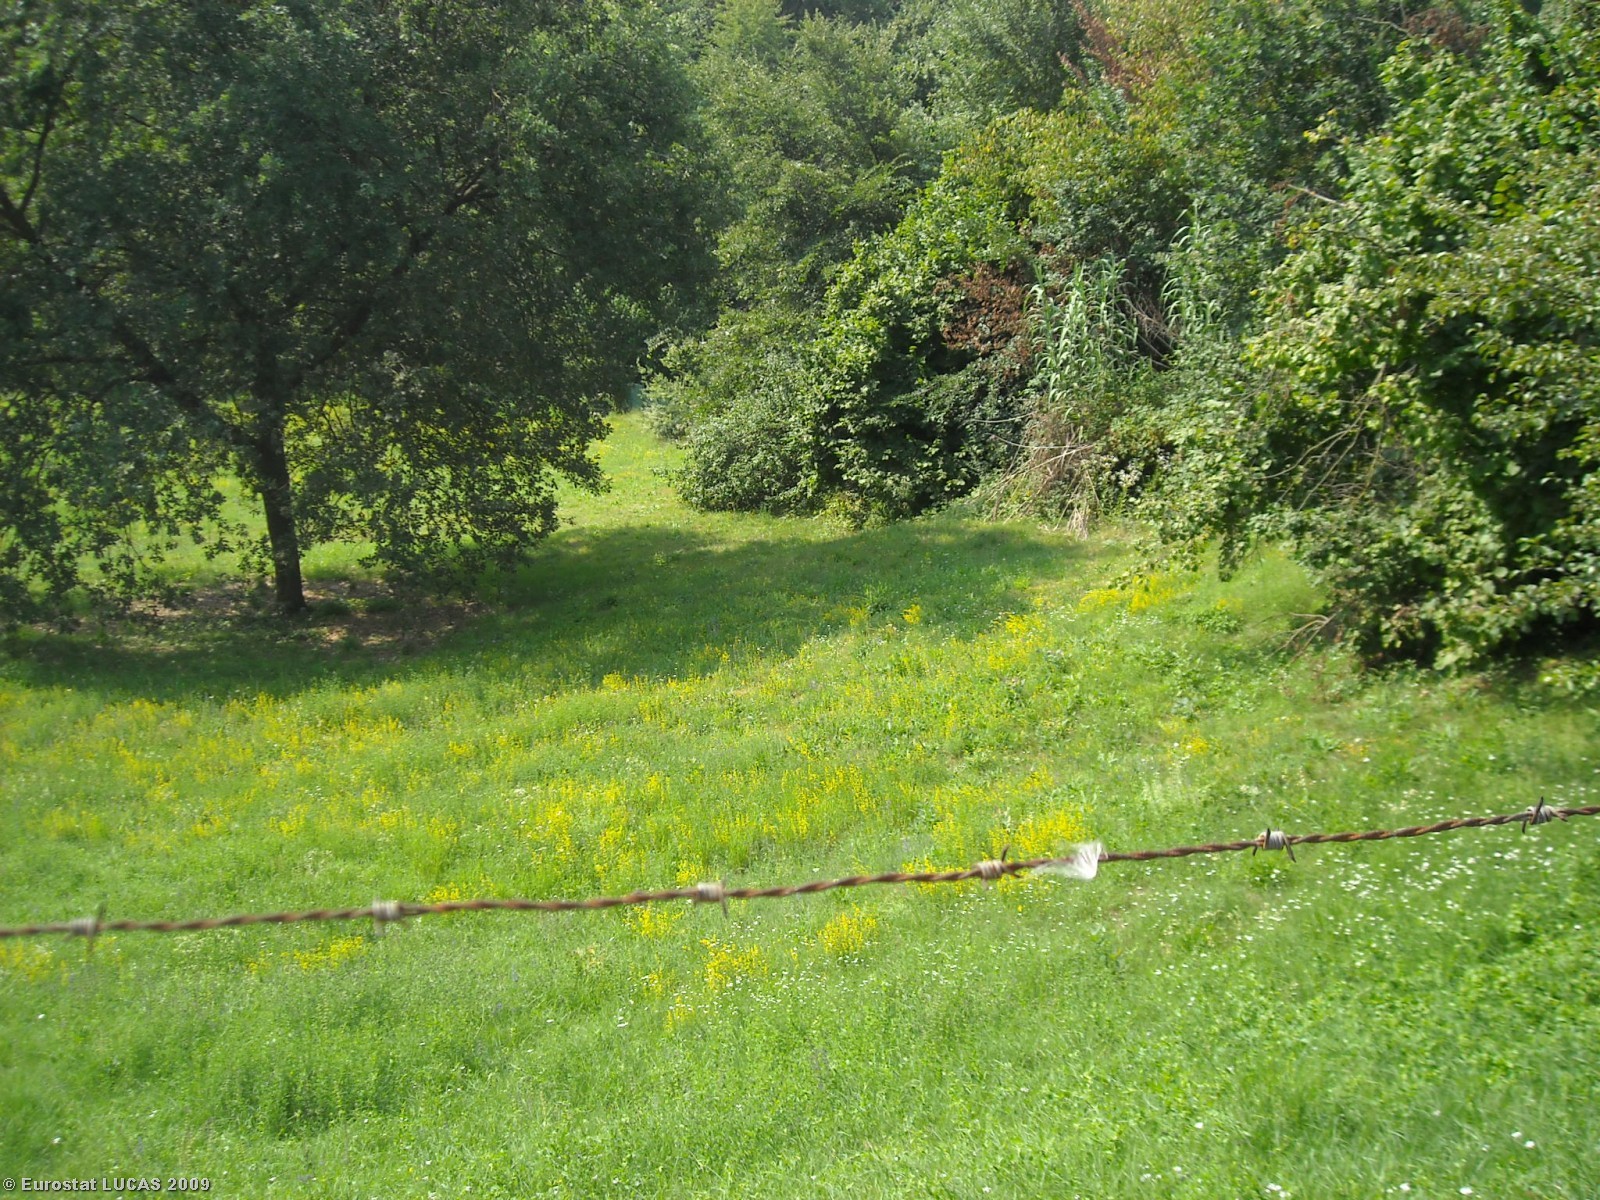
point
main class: Woodland
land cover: Broadleaved woodland
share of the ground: 25 - 50 %
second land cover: Grassland with sparse tree/shrub cover
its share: 50 - 75 %
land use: Agriculture (excluding fallow land and kitchen gardens)
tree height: > 5 m
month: July
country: IT
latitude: 44.8922
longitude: 8.0917
